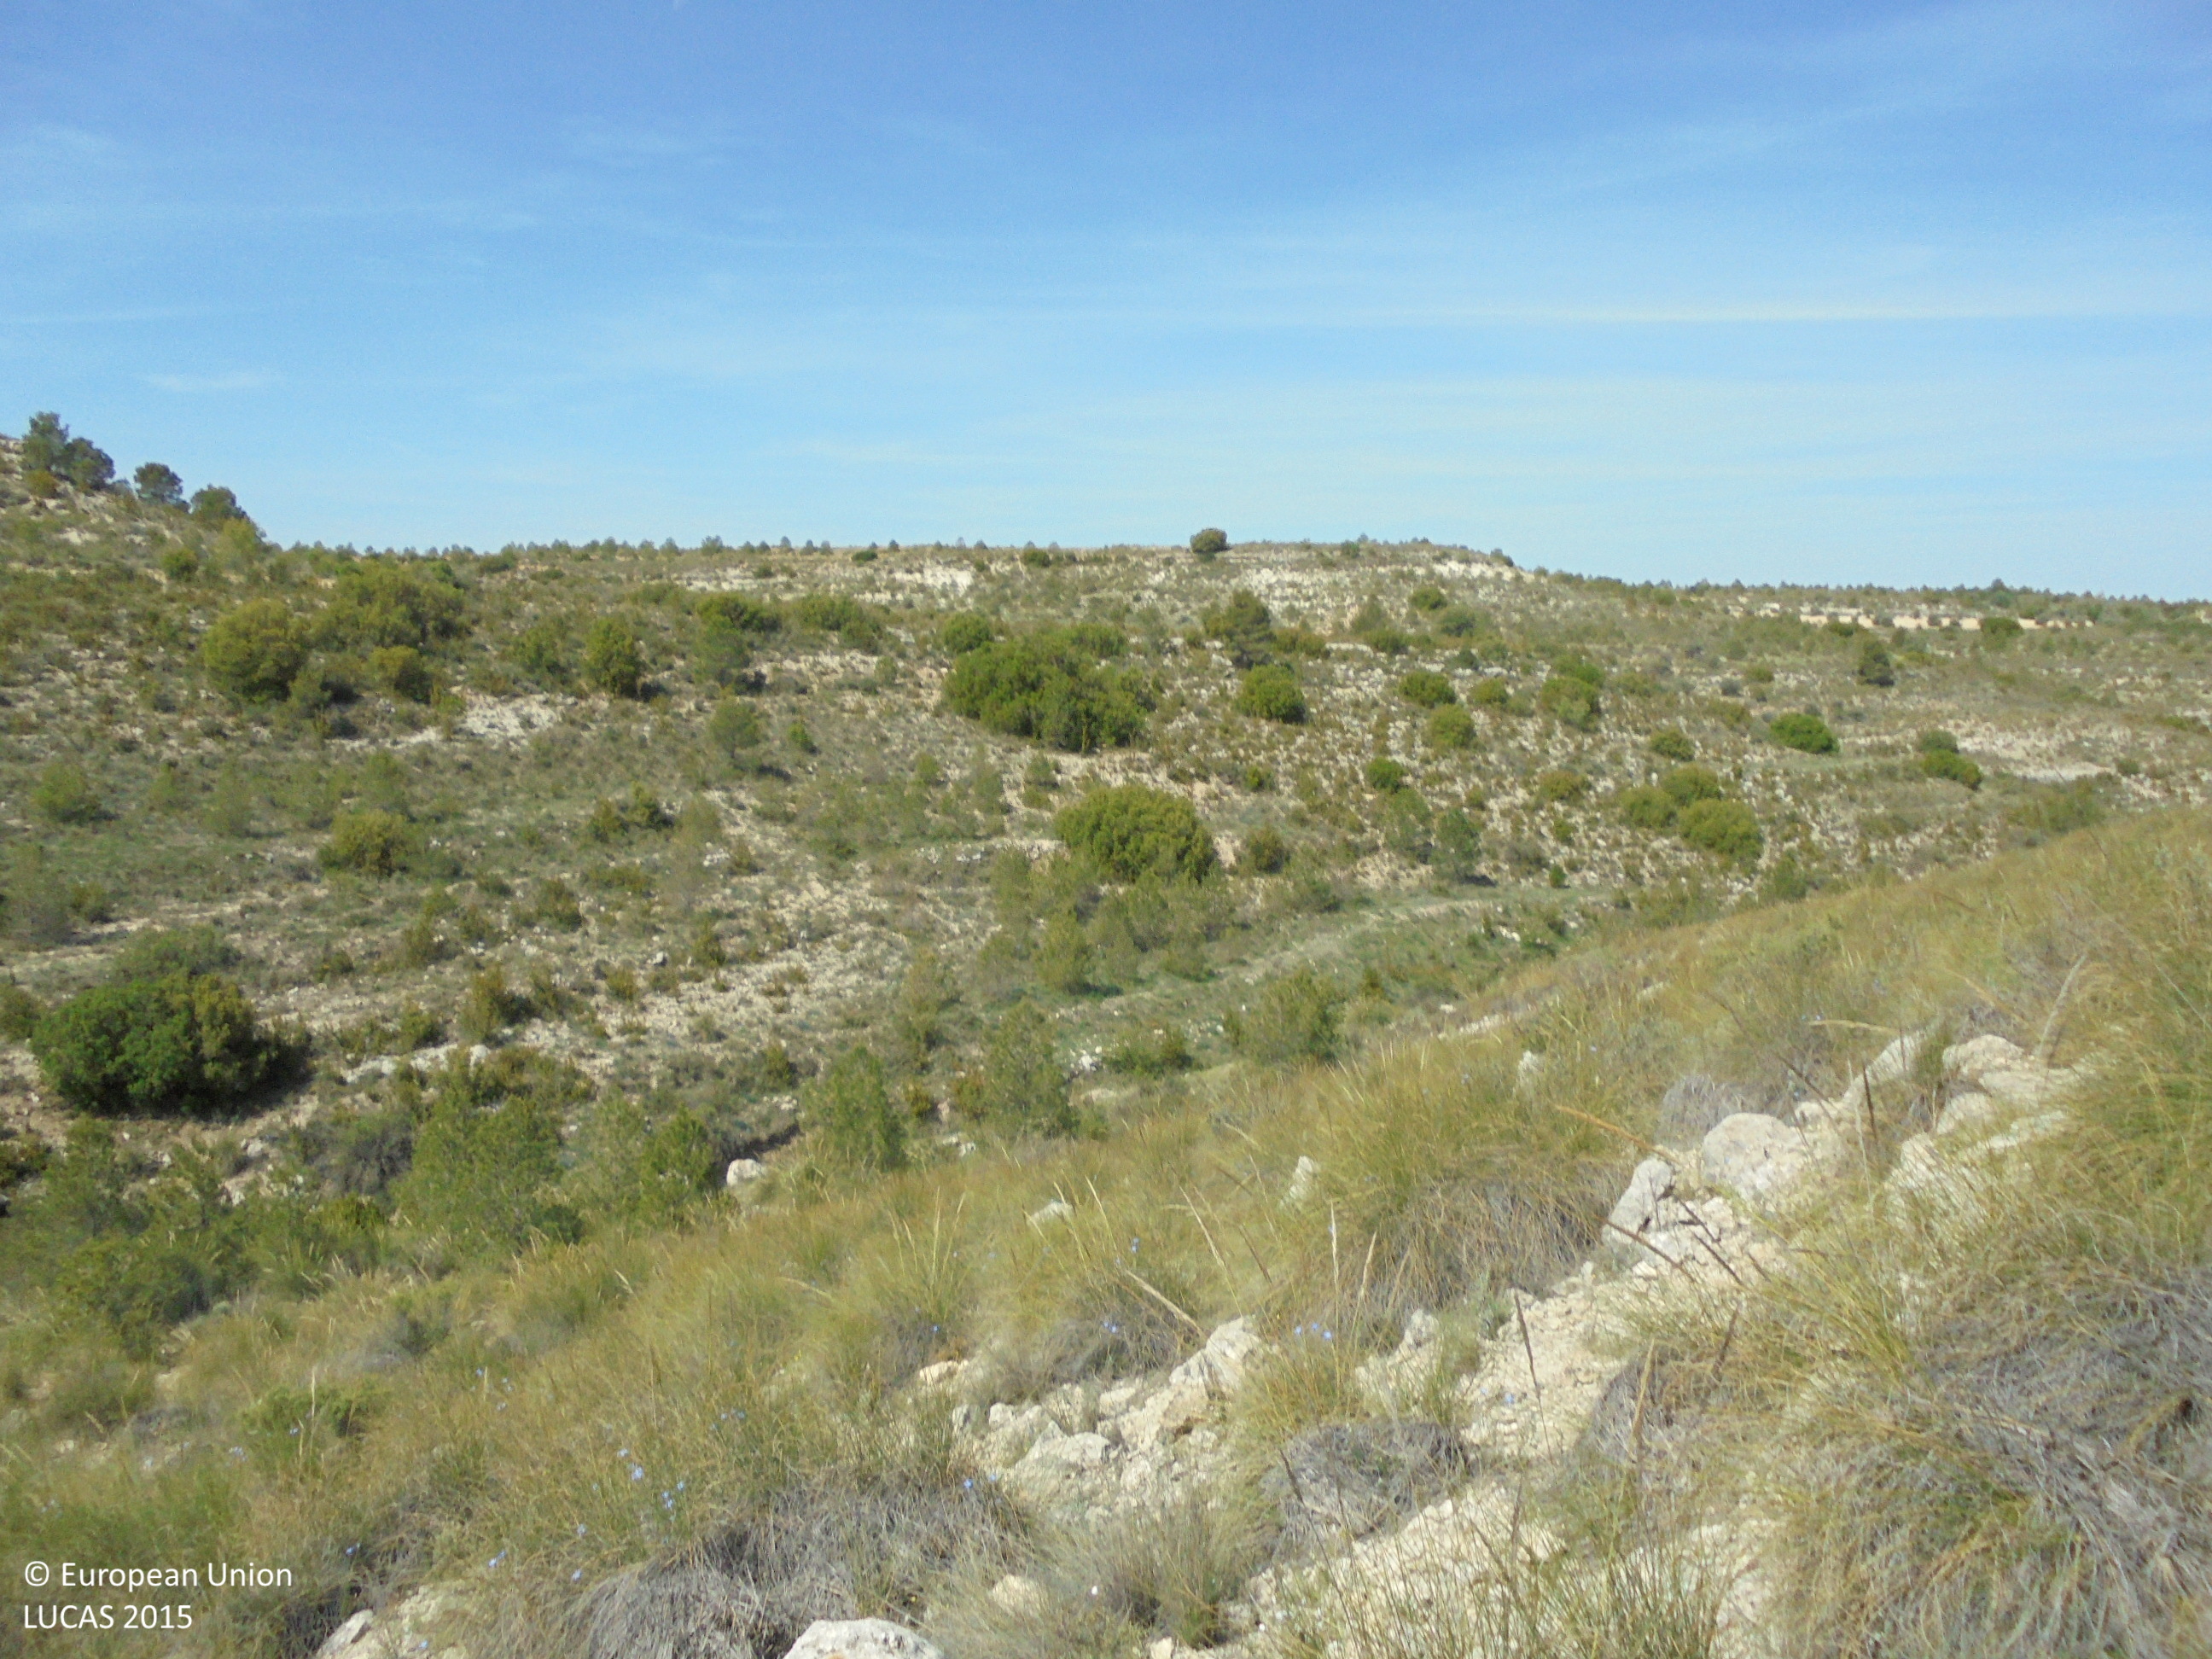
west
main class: Shrubland
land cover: Shrubland without tree cover
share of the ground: 50 - 75 %
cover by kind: shrubs 70 %, consolidated bare surface 15 %, unconsolidated bare surface 15 %
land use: Semi-natural and natural areas not in use
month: May
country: ES
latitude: 39.1515
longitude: -1.4902
